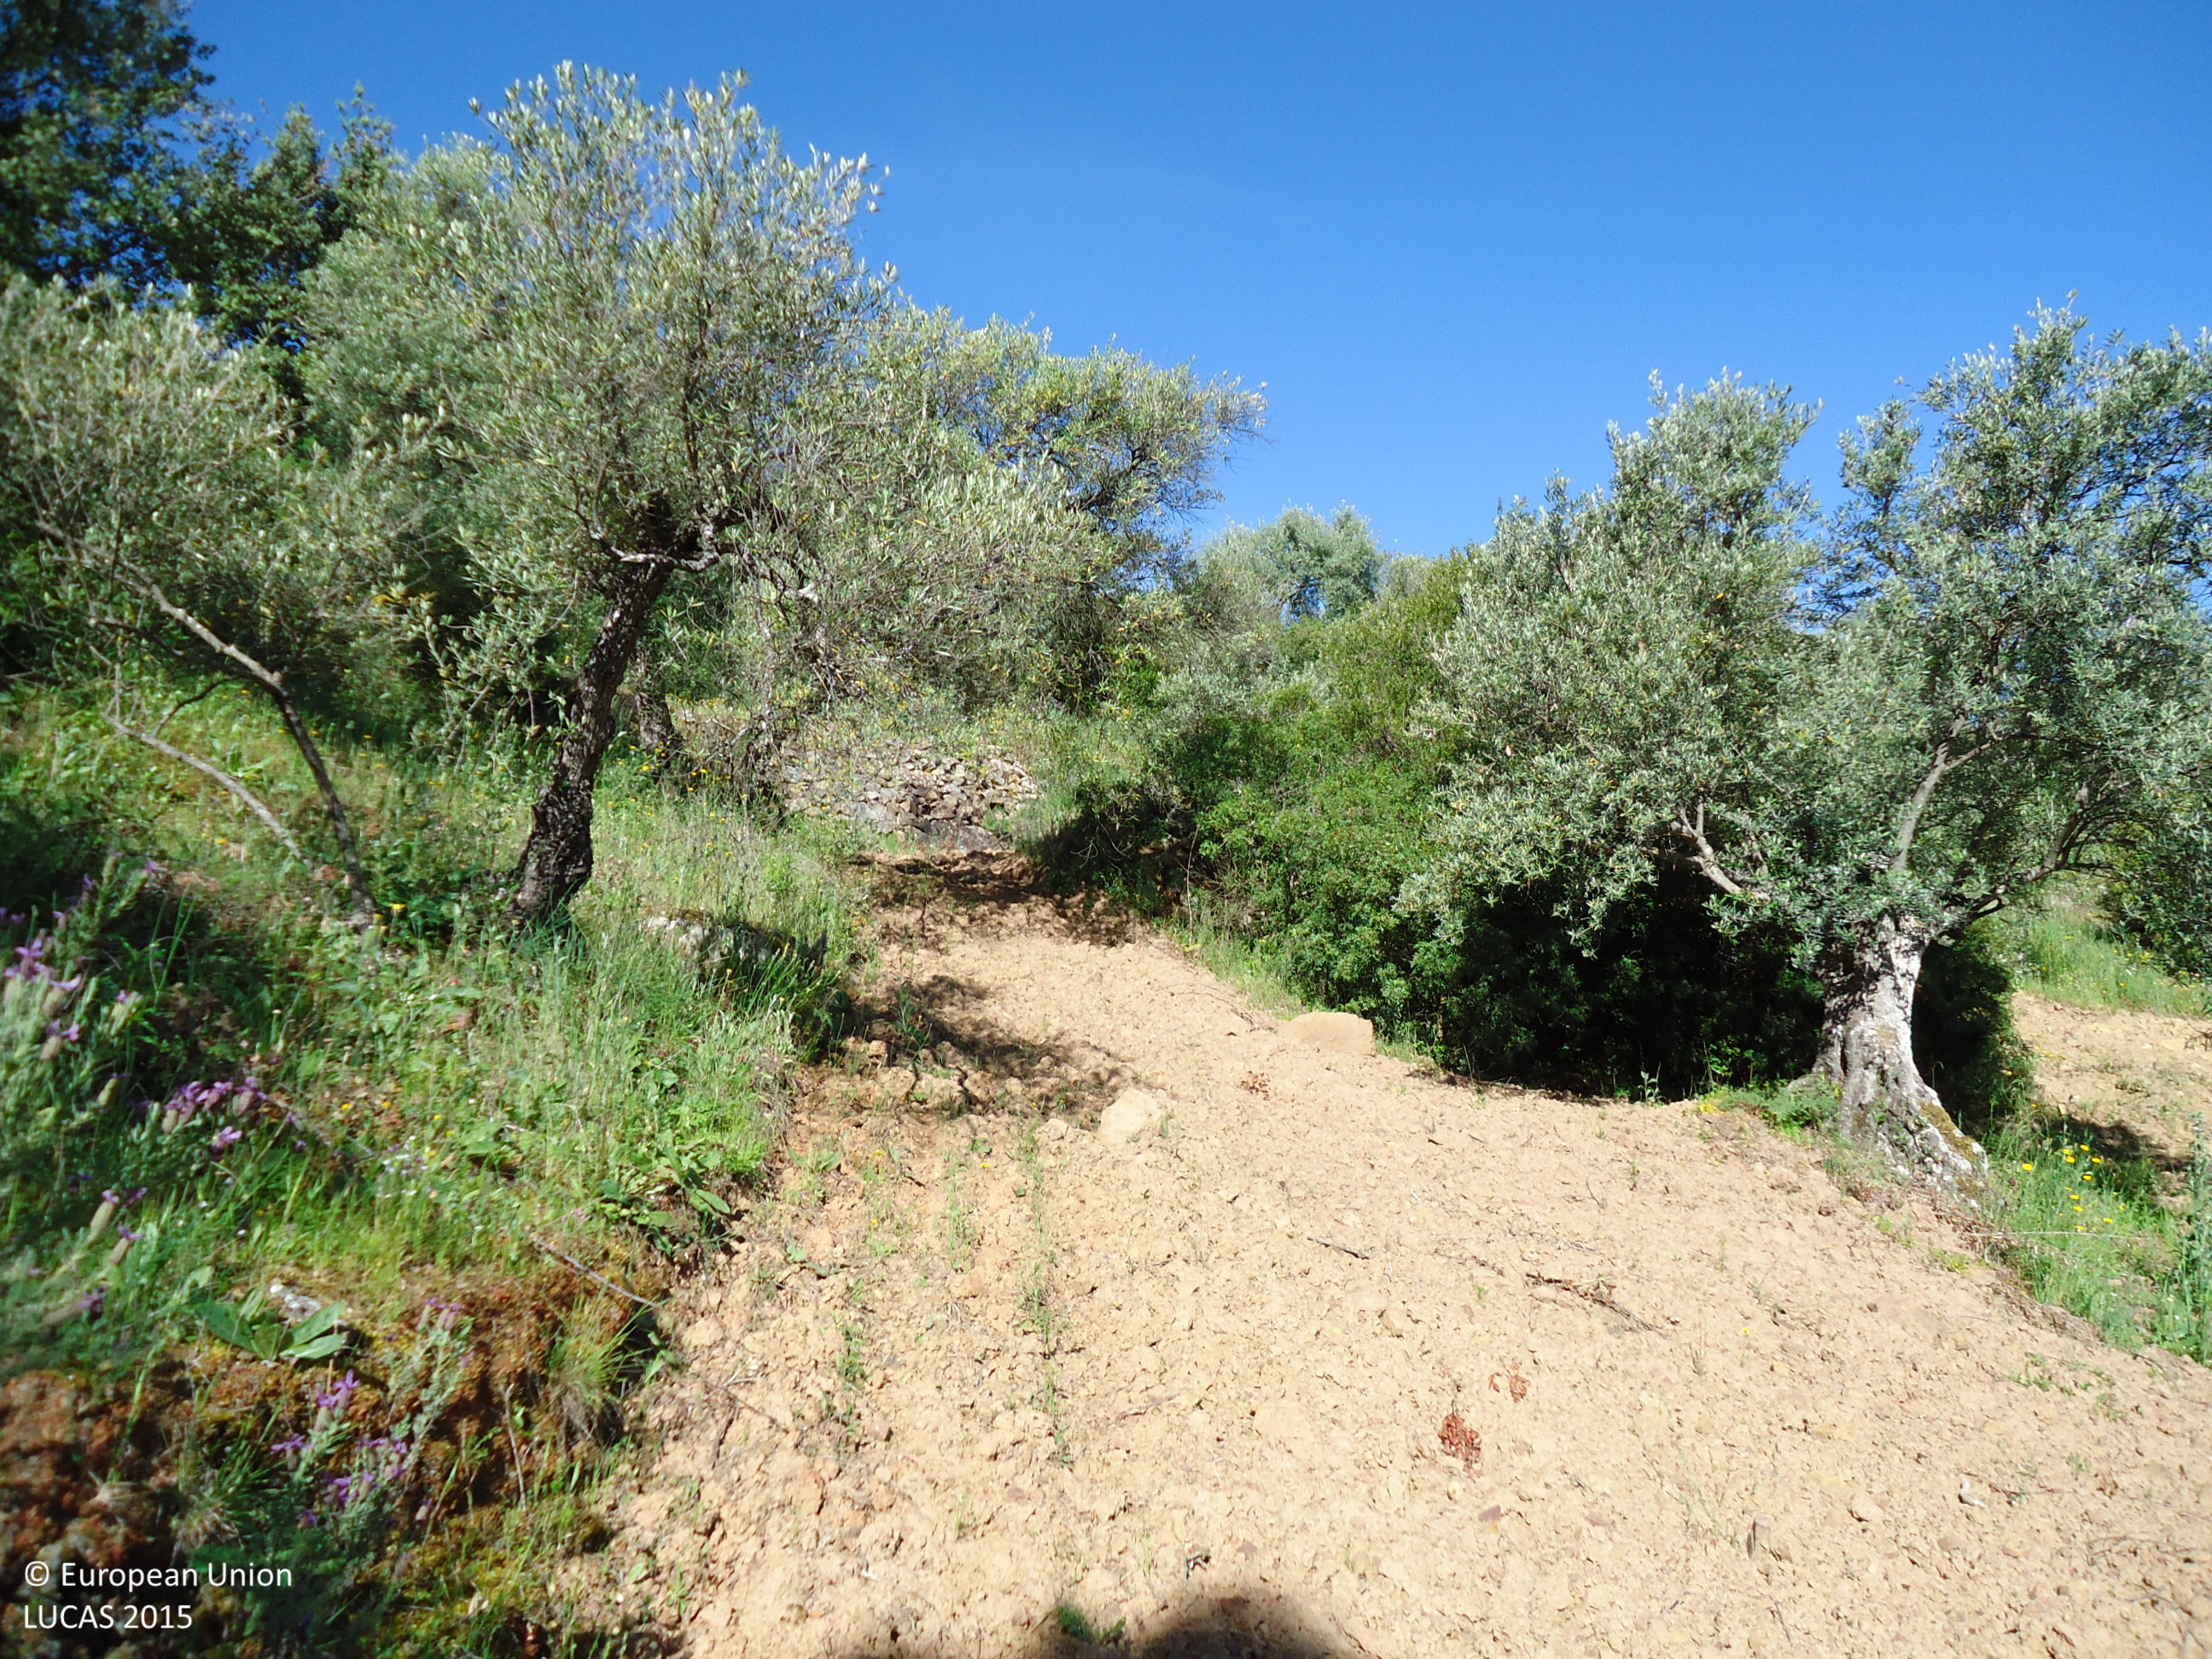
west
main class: Cropland
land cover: Olive groves
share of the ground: 50 - 75 %
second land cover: Other bare soil
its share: > 75 %
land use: Agriculture (excluding fallow land and kitchen gardens)
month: May
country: ES
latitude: 36.8637
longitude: -5.3375
